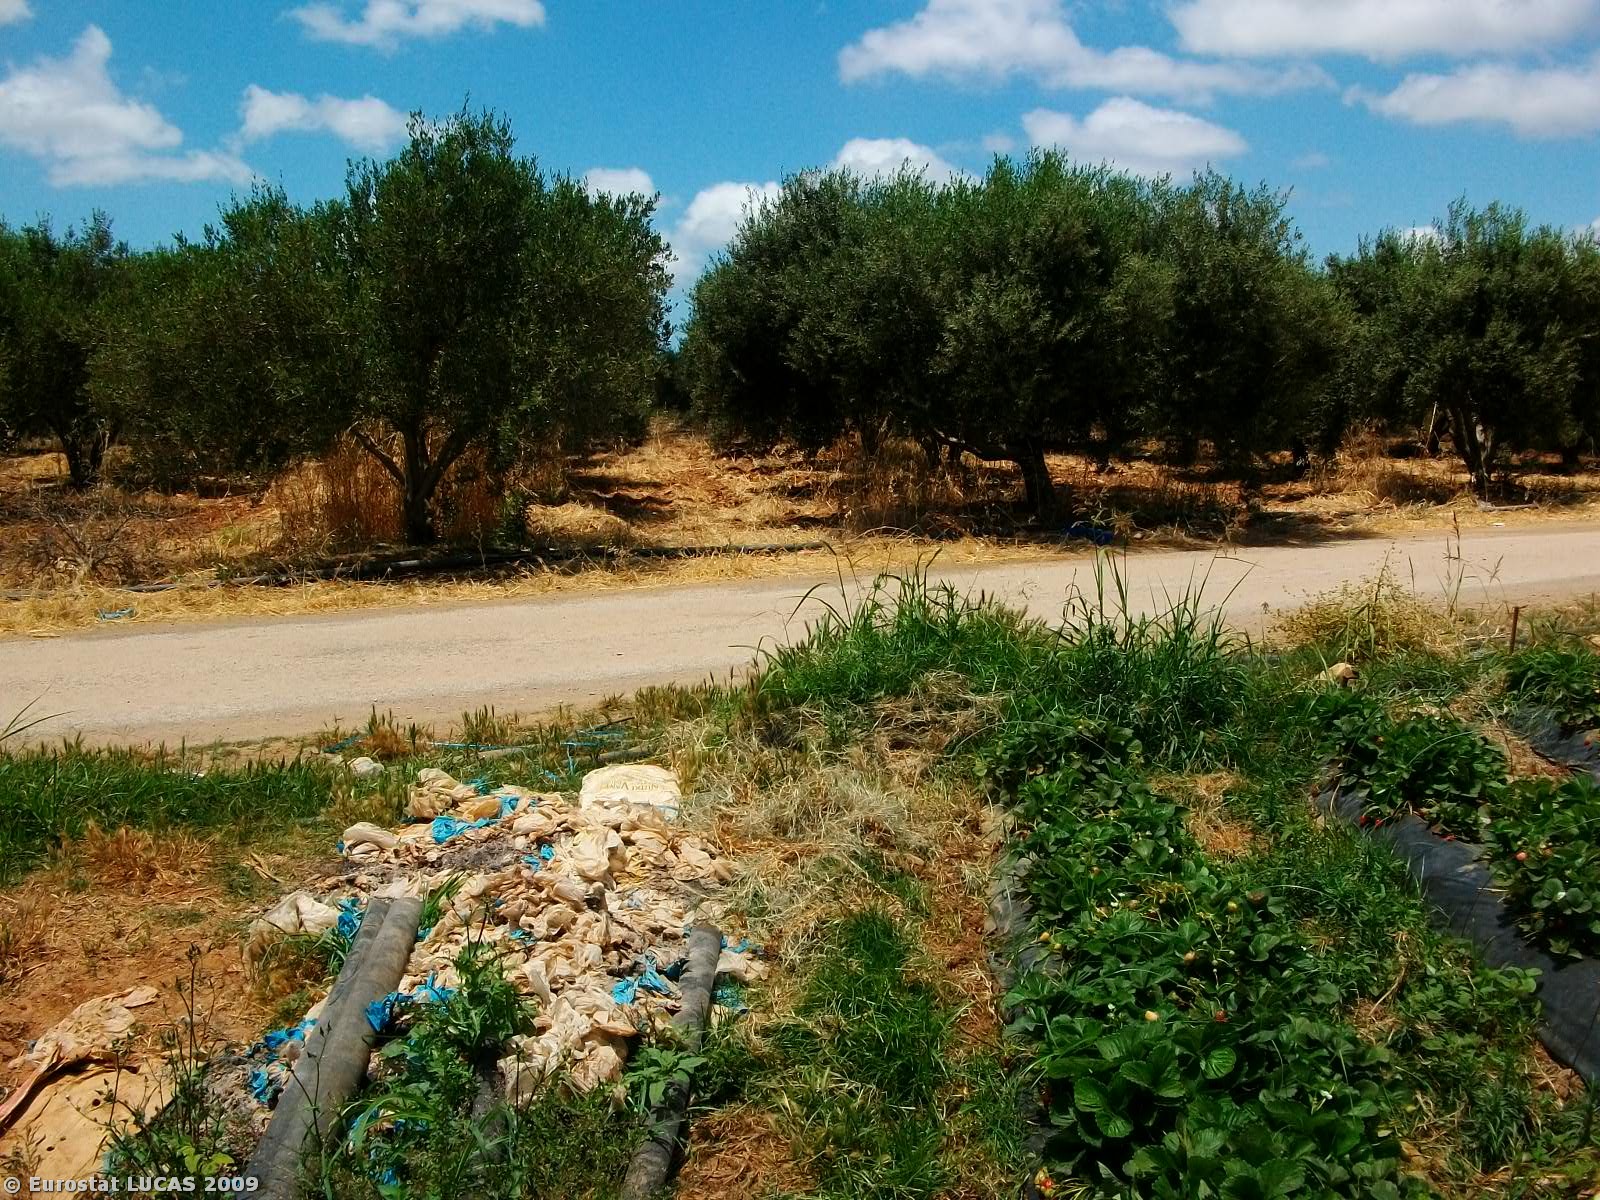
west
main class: Cropland
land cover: Strawberries
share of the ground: 50 - 75 %
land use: Agriculture (excluding fallow land and kitchen gardens)
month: June
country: GR
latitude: 35.0476
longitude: 24.9501
